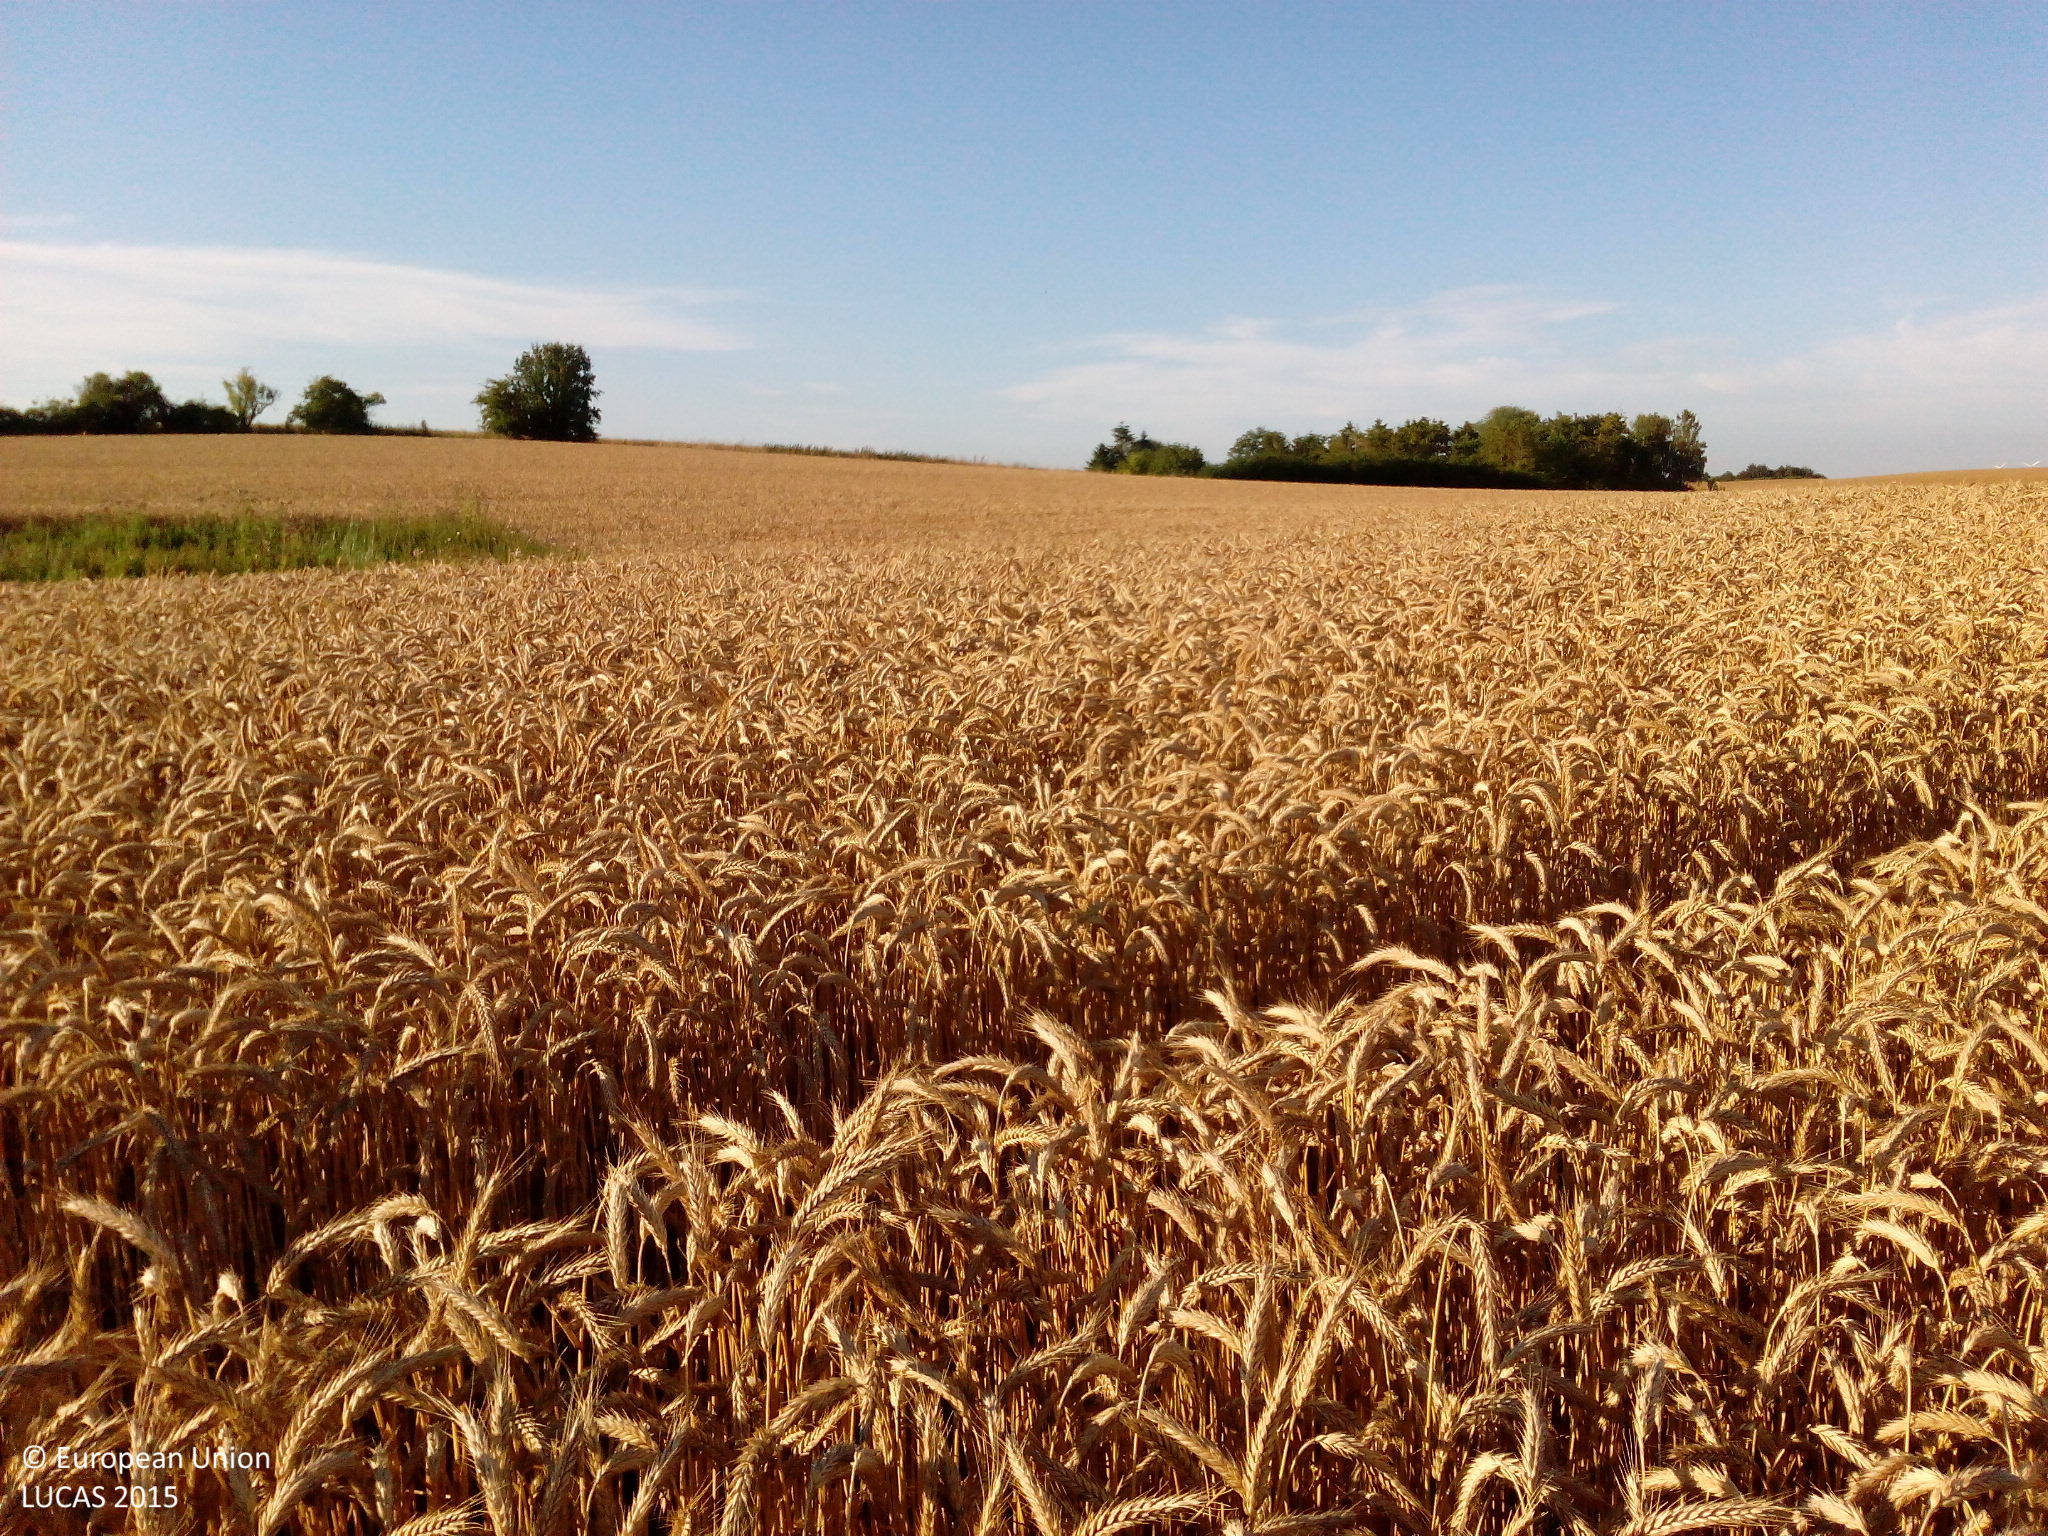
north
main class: Cropland
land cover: Common wheat
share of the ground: > 75 %
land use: Agriculture (excluding fallow land and kitchen gardens)
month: August
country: DK
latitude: 55.5648
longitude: 11.7269
